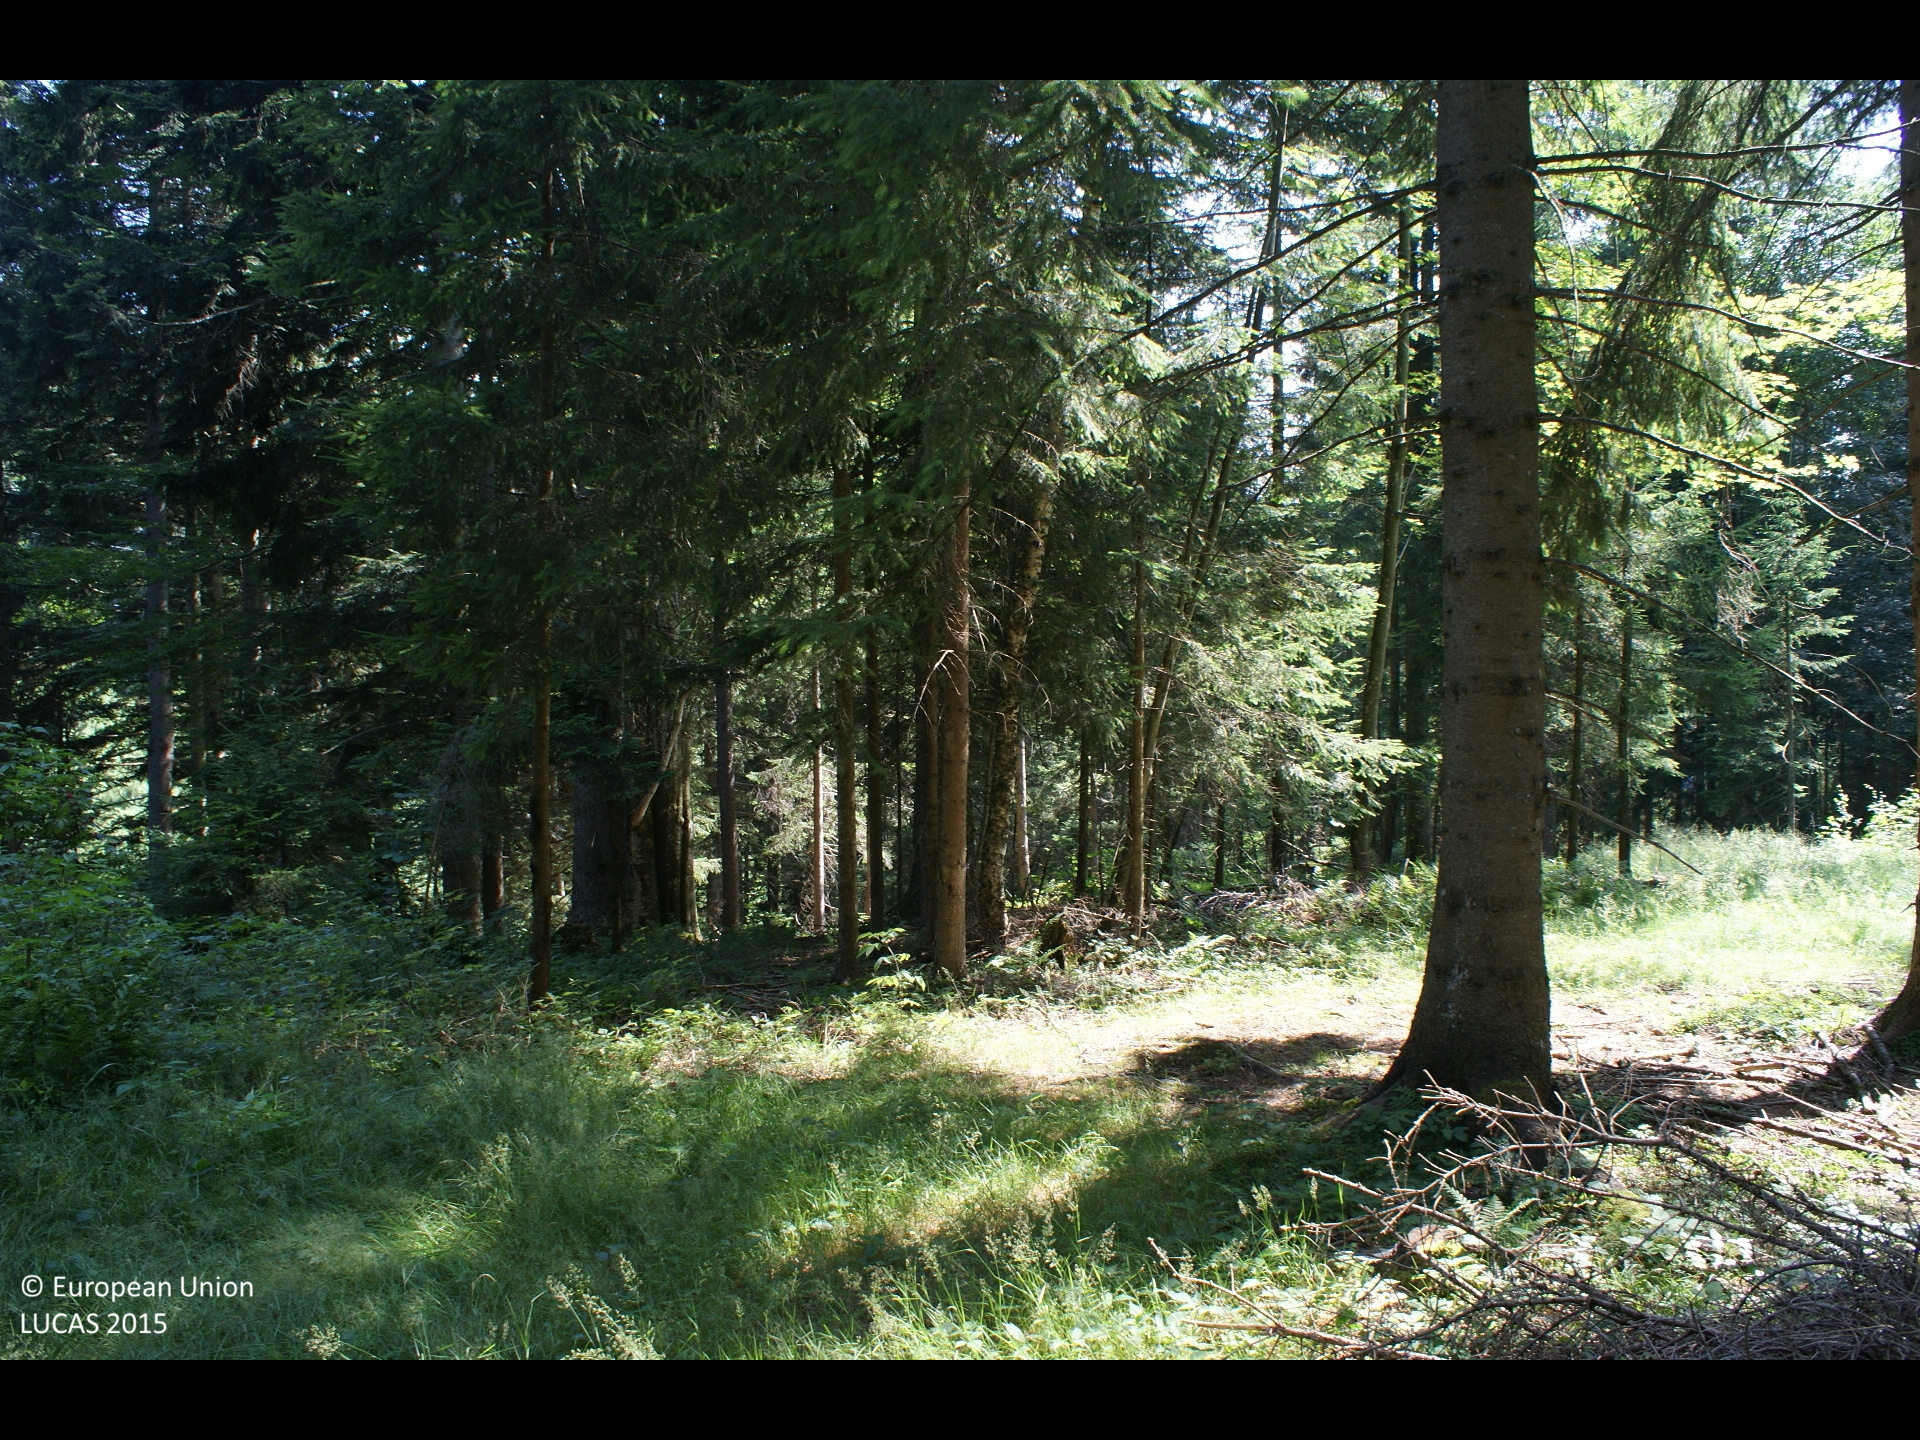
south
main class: Woodland
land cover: Spruce dominated coniferous woodland
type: alpine coniferous forest
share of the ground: > 75 %
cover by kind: coniferous forest trees 70 %, herbaceous plants 15 %, broadleaved forest trees 10 %, shrubs 5 %
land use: Forestry
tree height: > 5 m
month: July
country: AT
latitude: 47.8766
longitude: 15.3631
